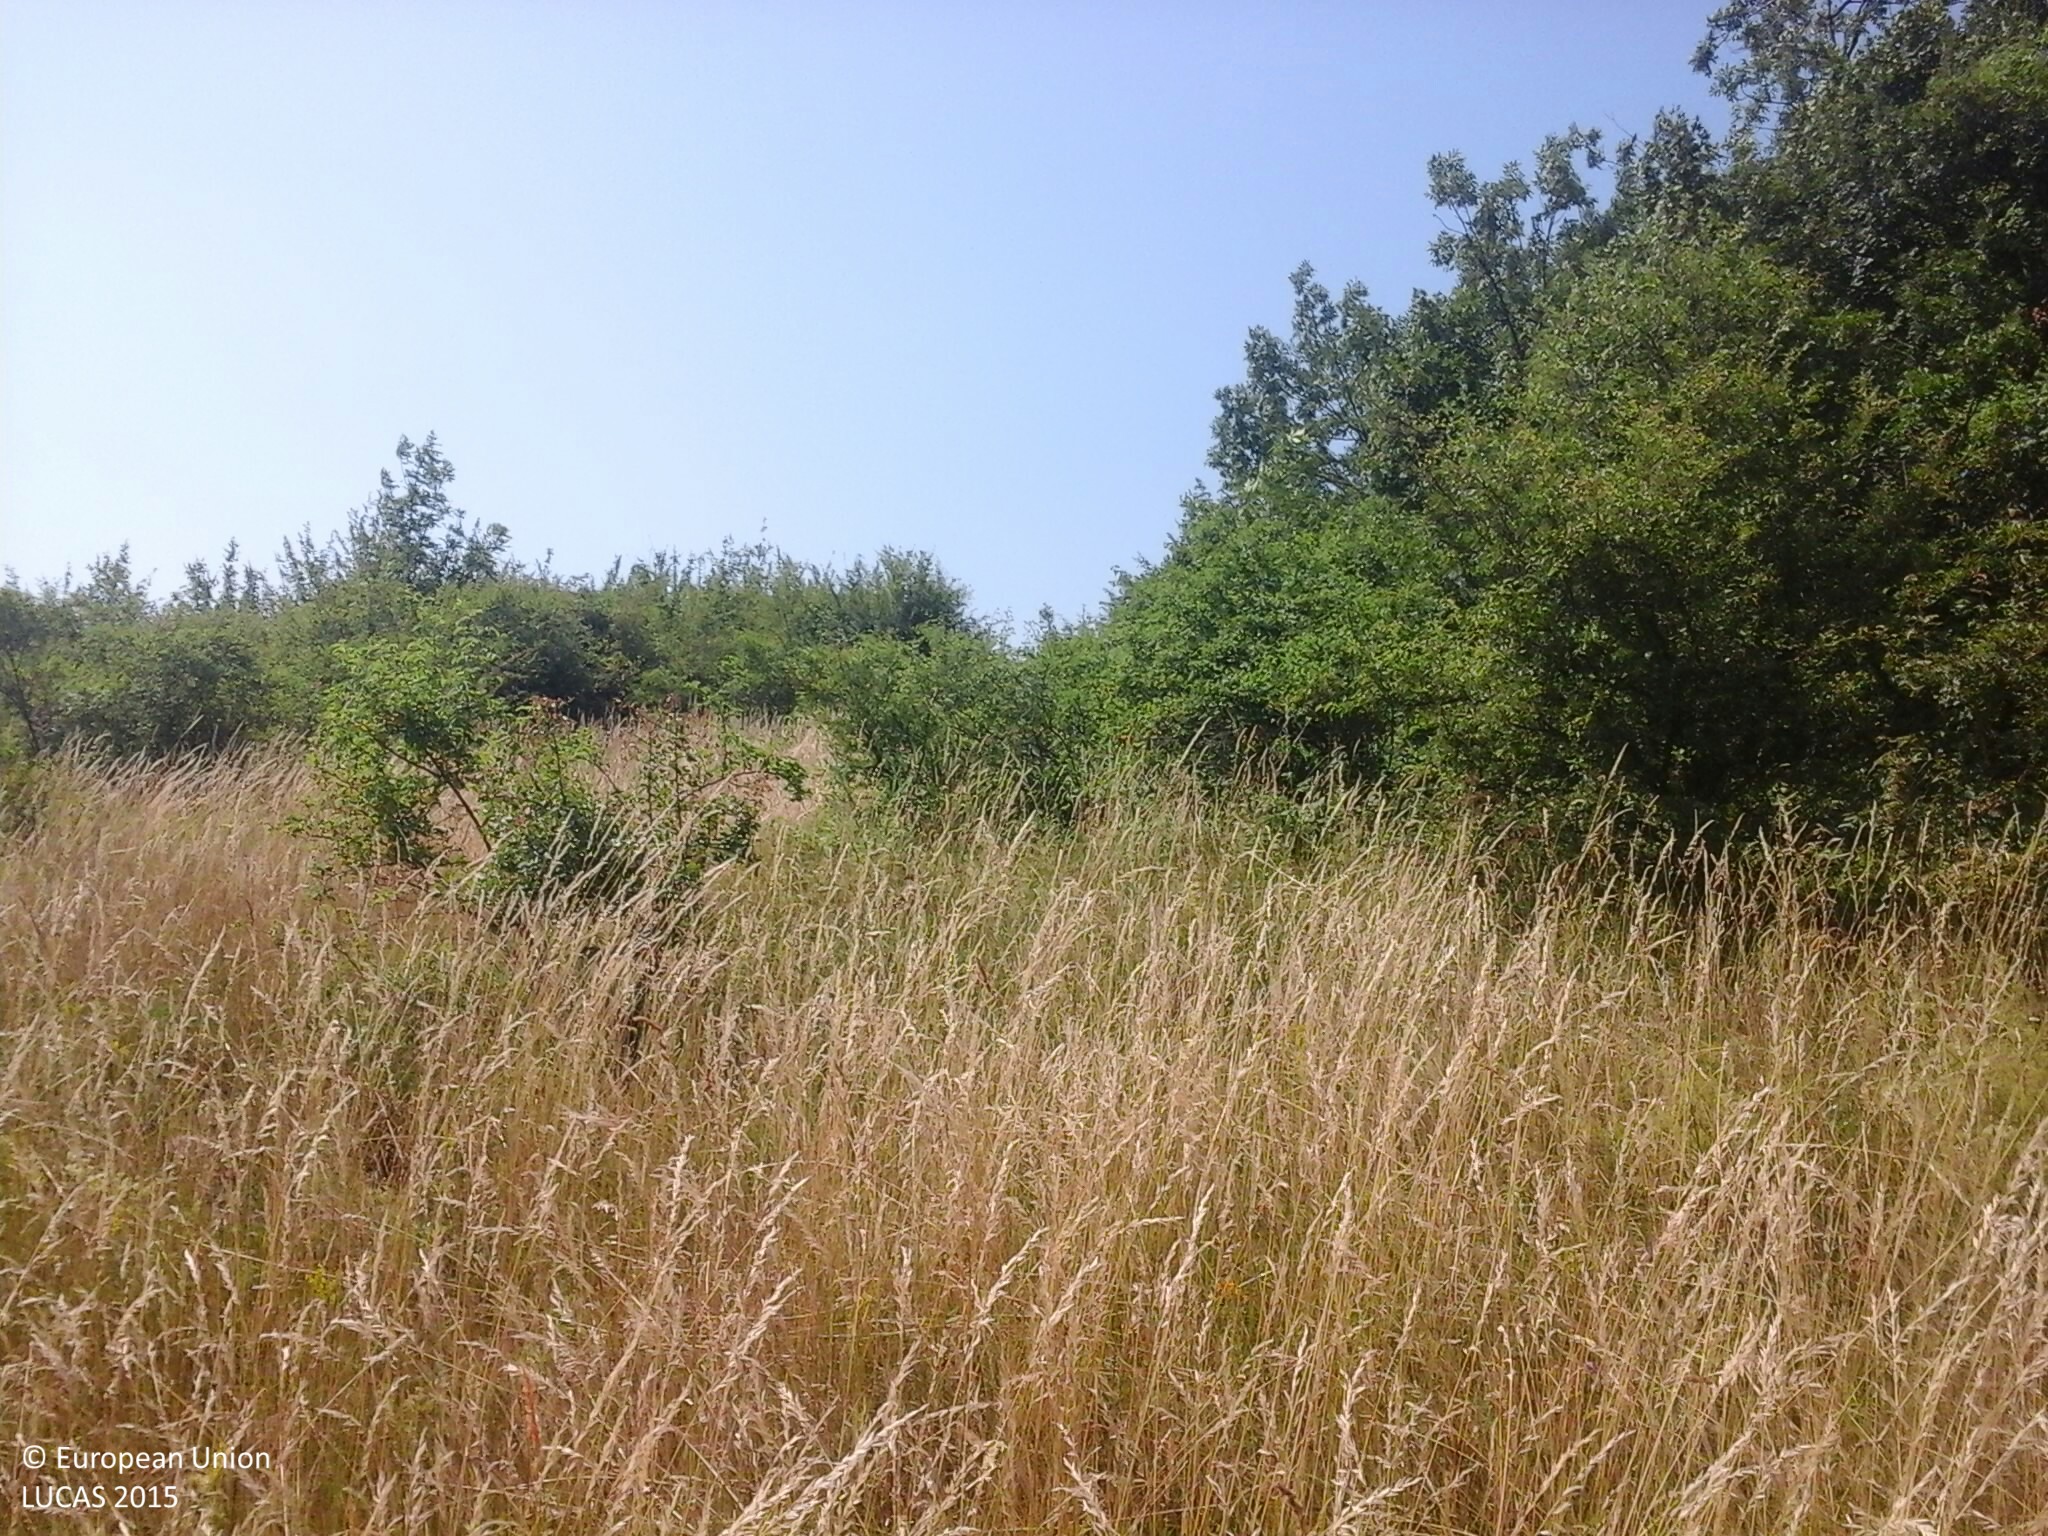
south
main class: Grassland
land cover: Grassland without tree/shrub cover
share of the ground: > 75 %
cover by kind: herbaceous plants 100 %
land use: Agriculture (excluding fallow land and kitchen gardens)
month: July
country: HU
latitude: 47.2011
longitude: 17.8634
